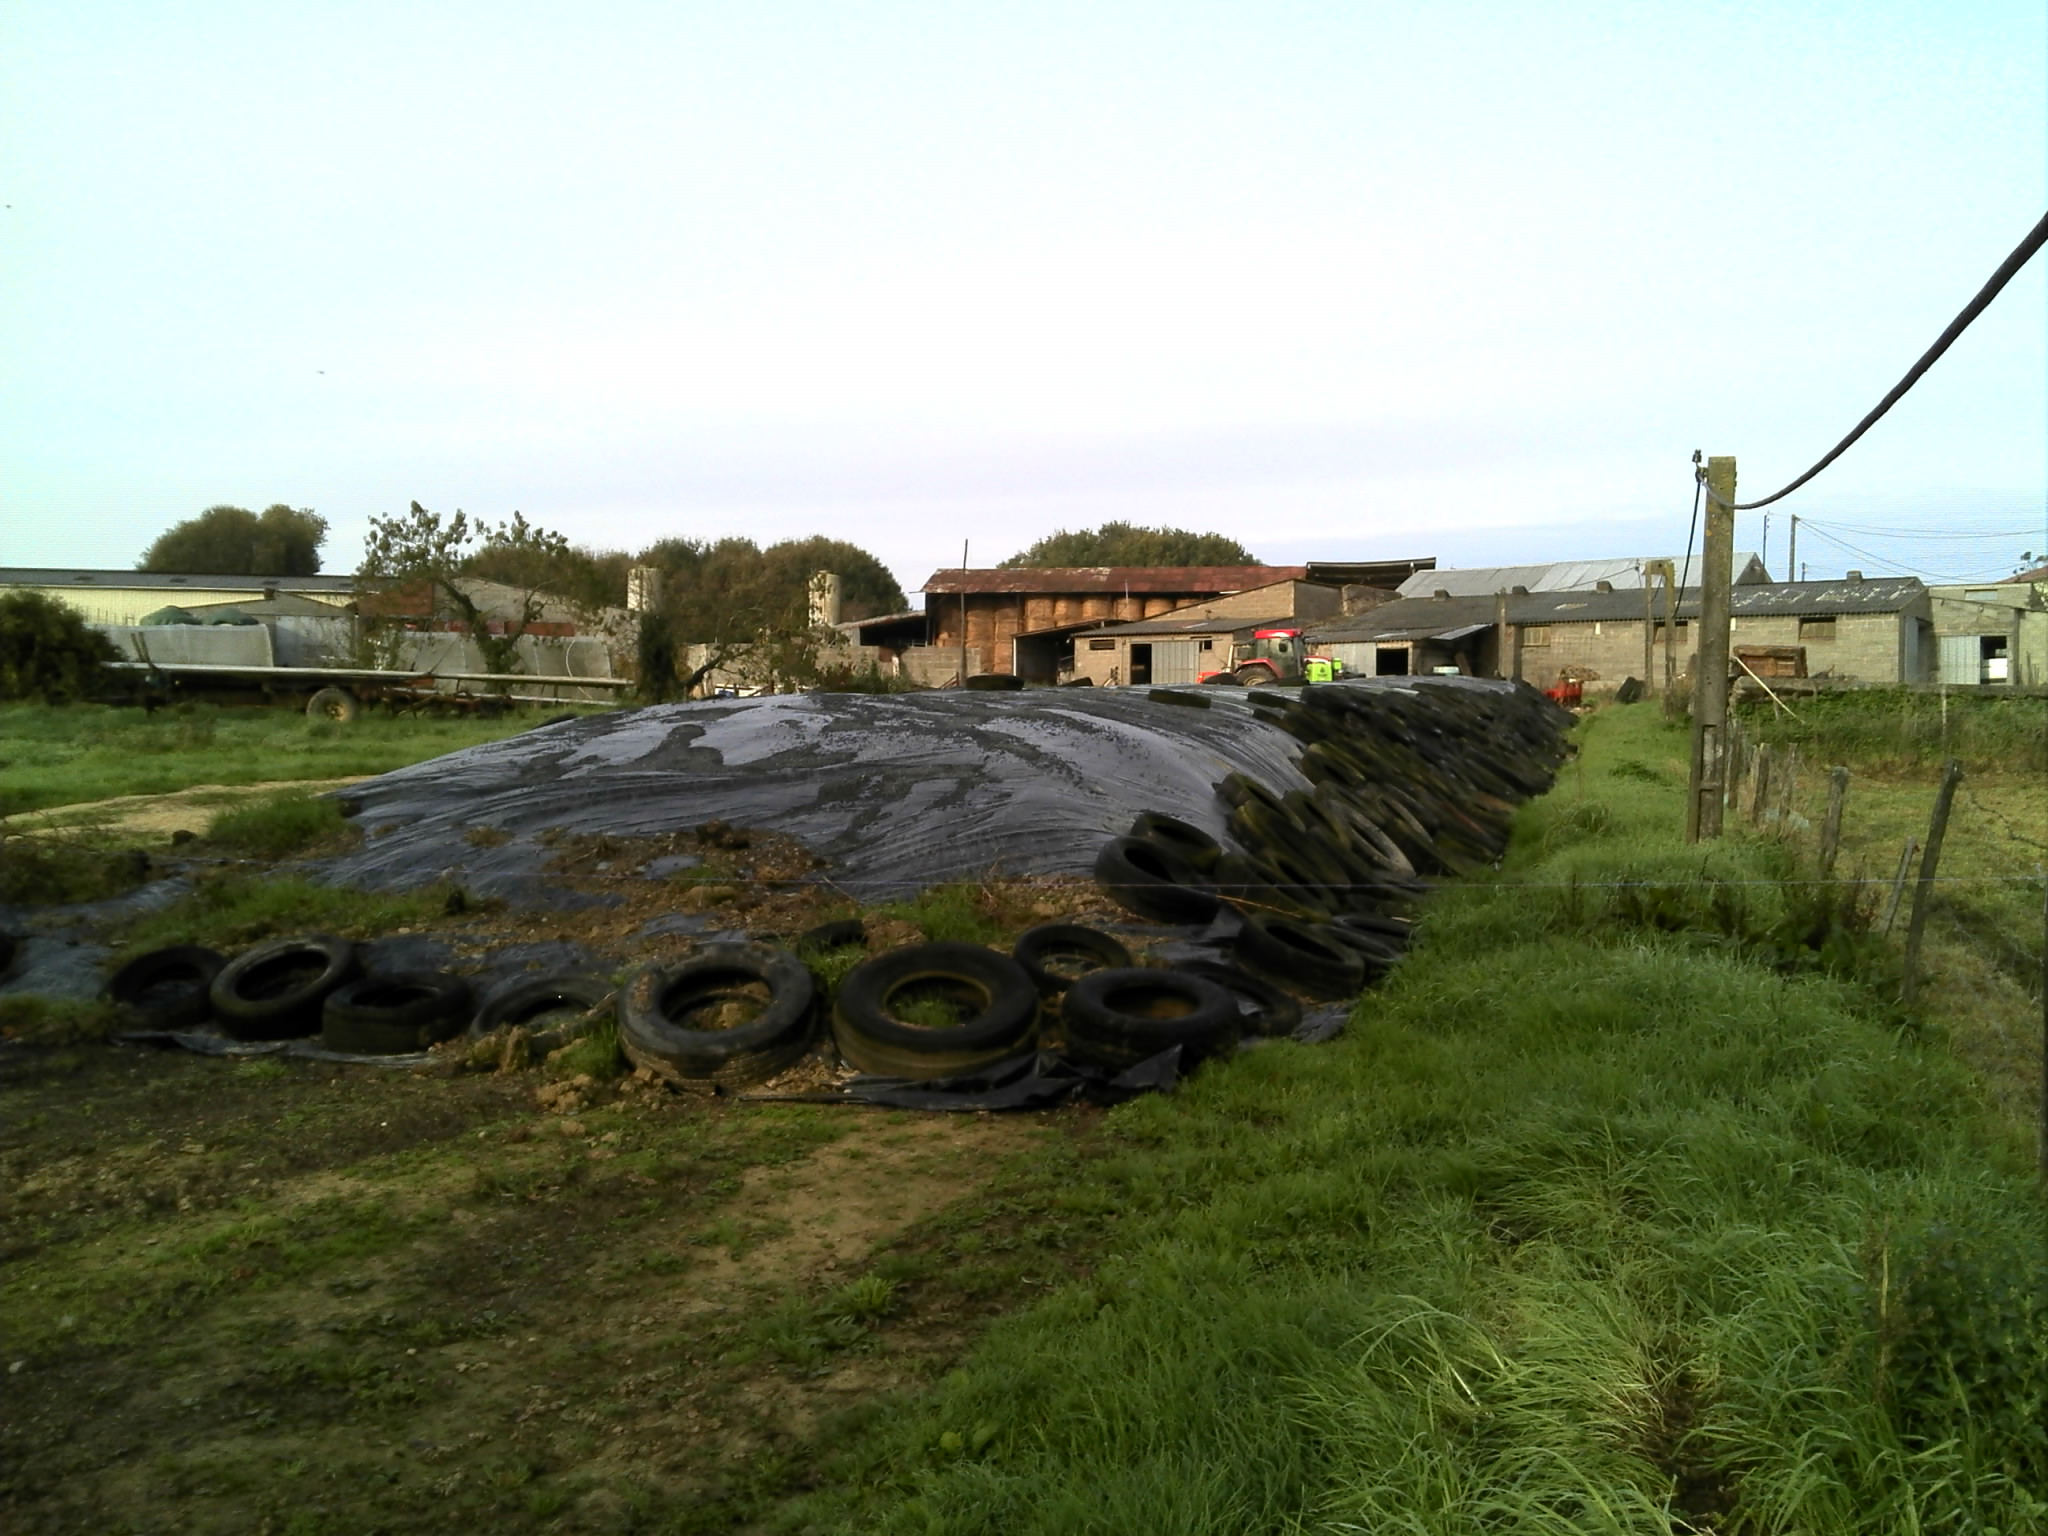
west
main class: Grassland
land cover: Grassland without tree/shrub cover
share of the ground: > 75 %
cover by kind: herbaceous plants 100 %
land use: Agriculture (excluding fallow land and kitchen gardens)
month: October
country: FR
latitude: 47.2724
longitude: -0.9935
